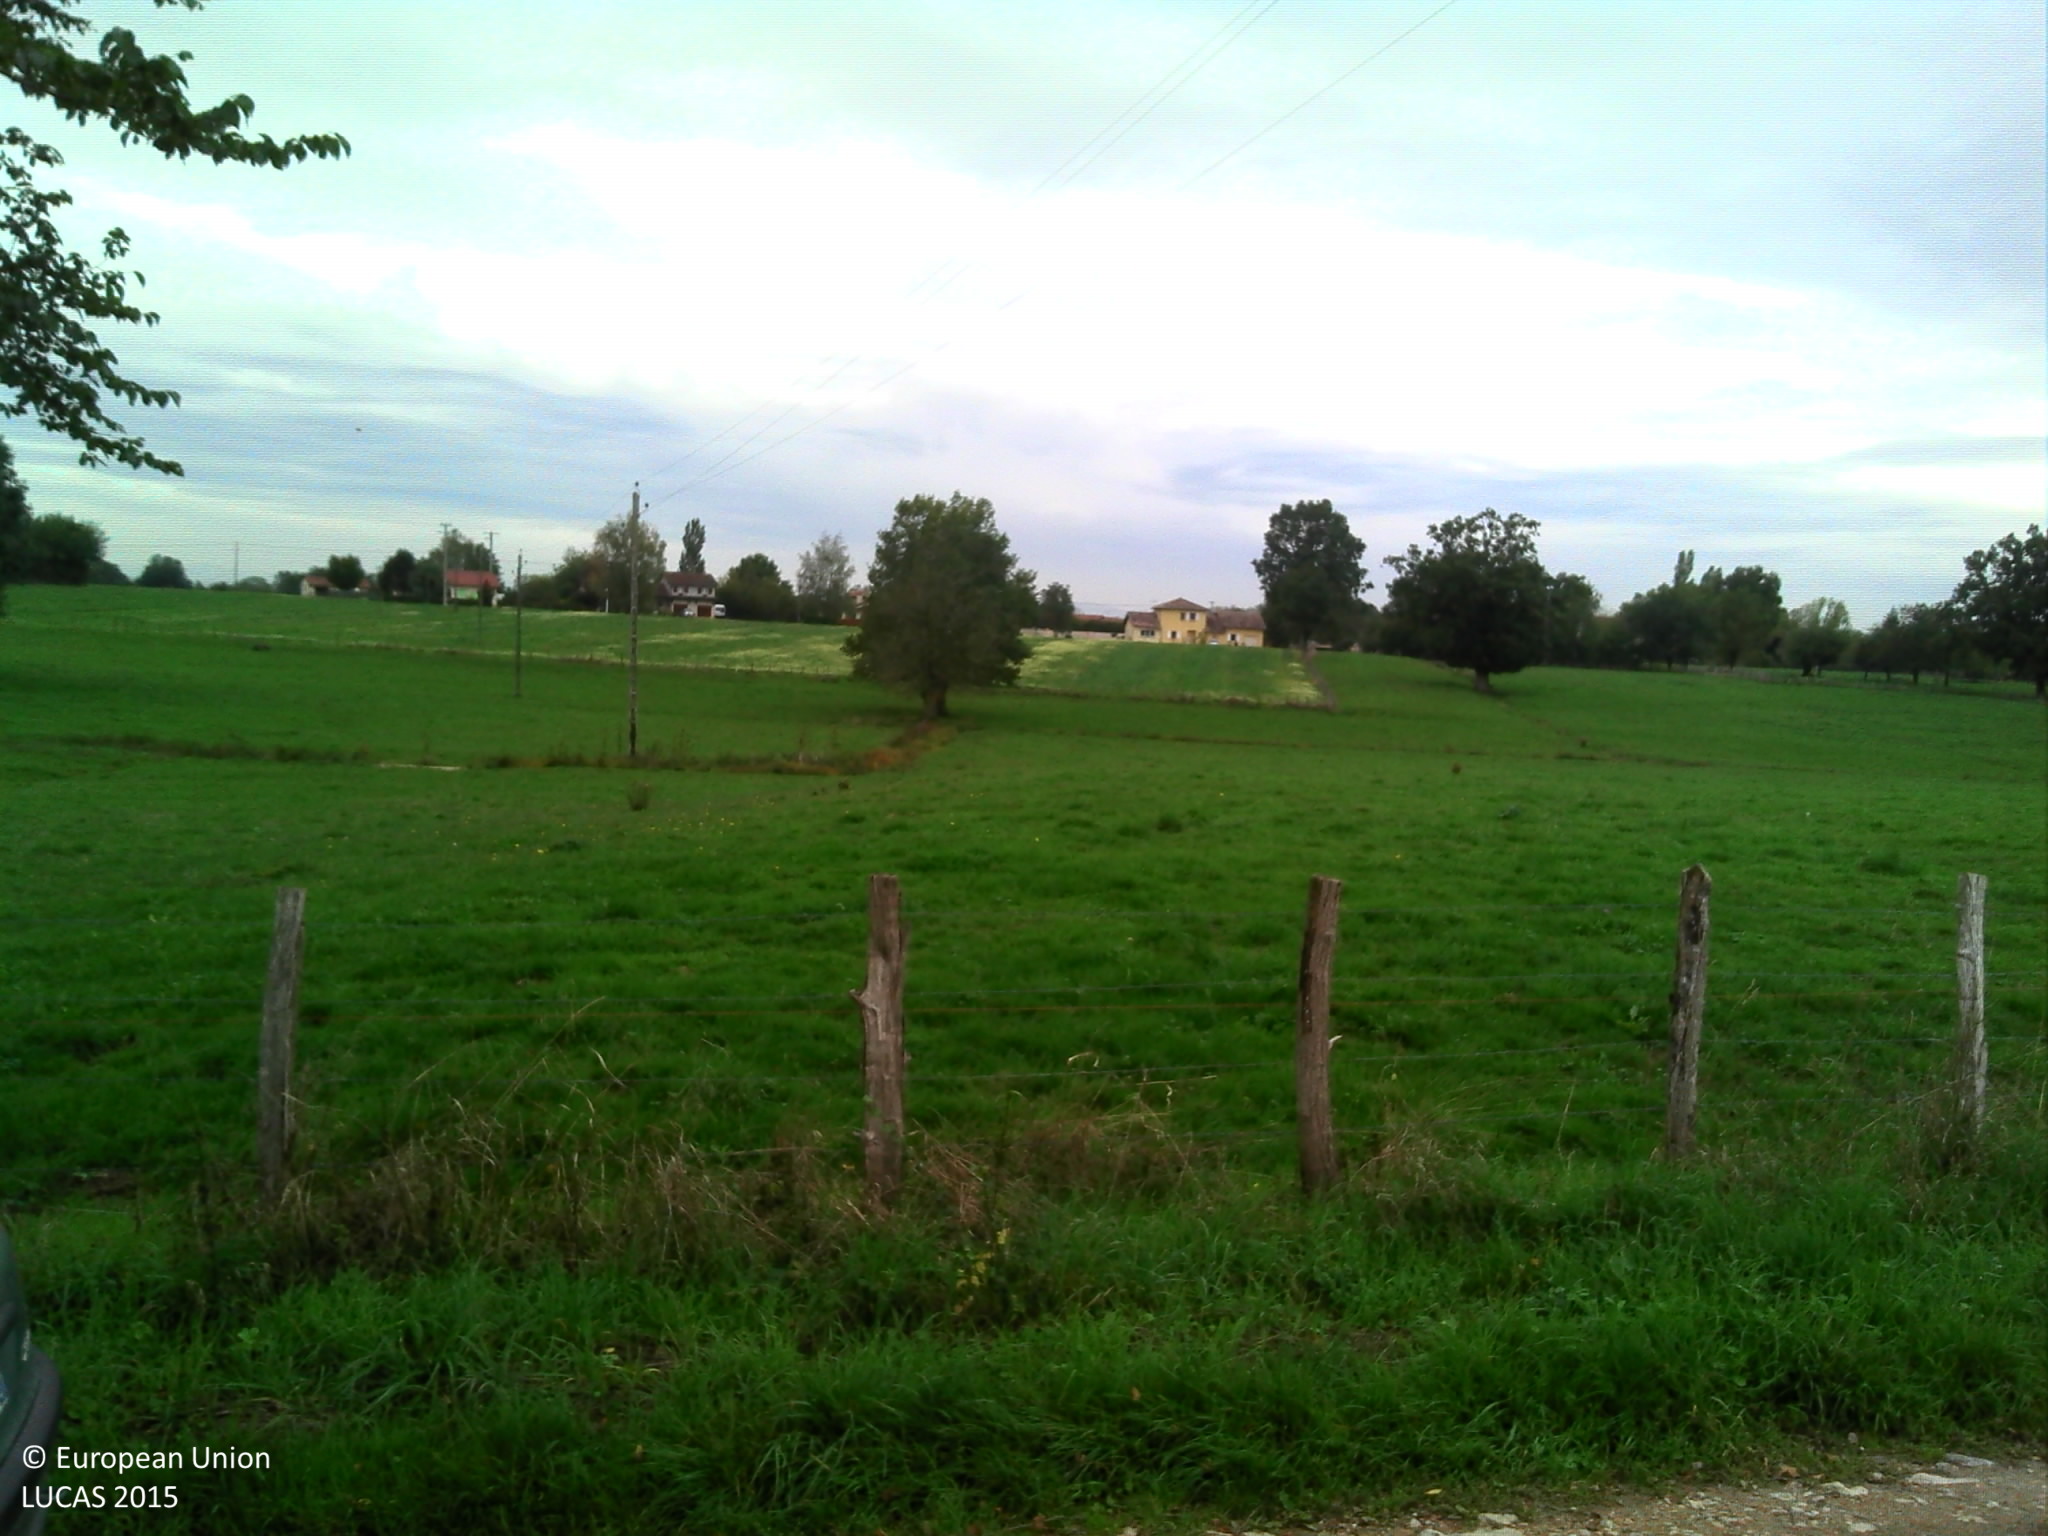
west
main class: Cropland
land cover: Lucerne
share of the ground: > 75 %
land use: Agriculture (excluding fallow land and kitchen gardens)
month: October
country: FR
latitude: 46.4492
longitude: 4.9641
